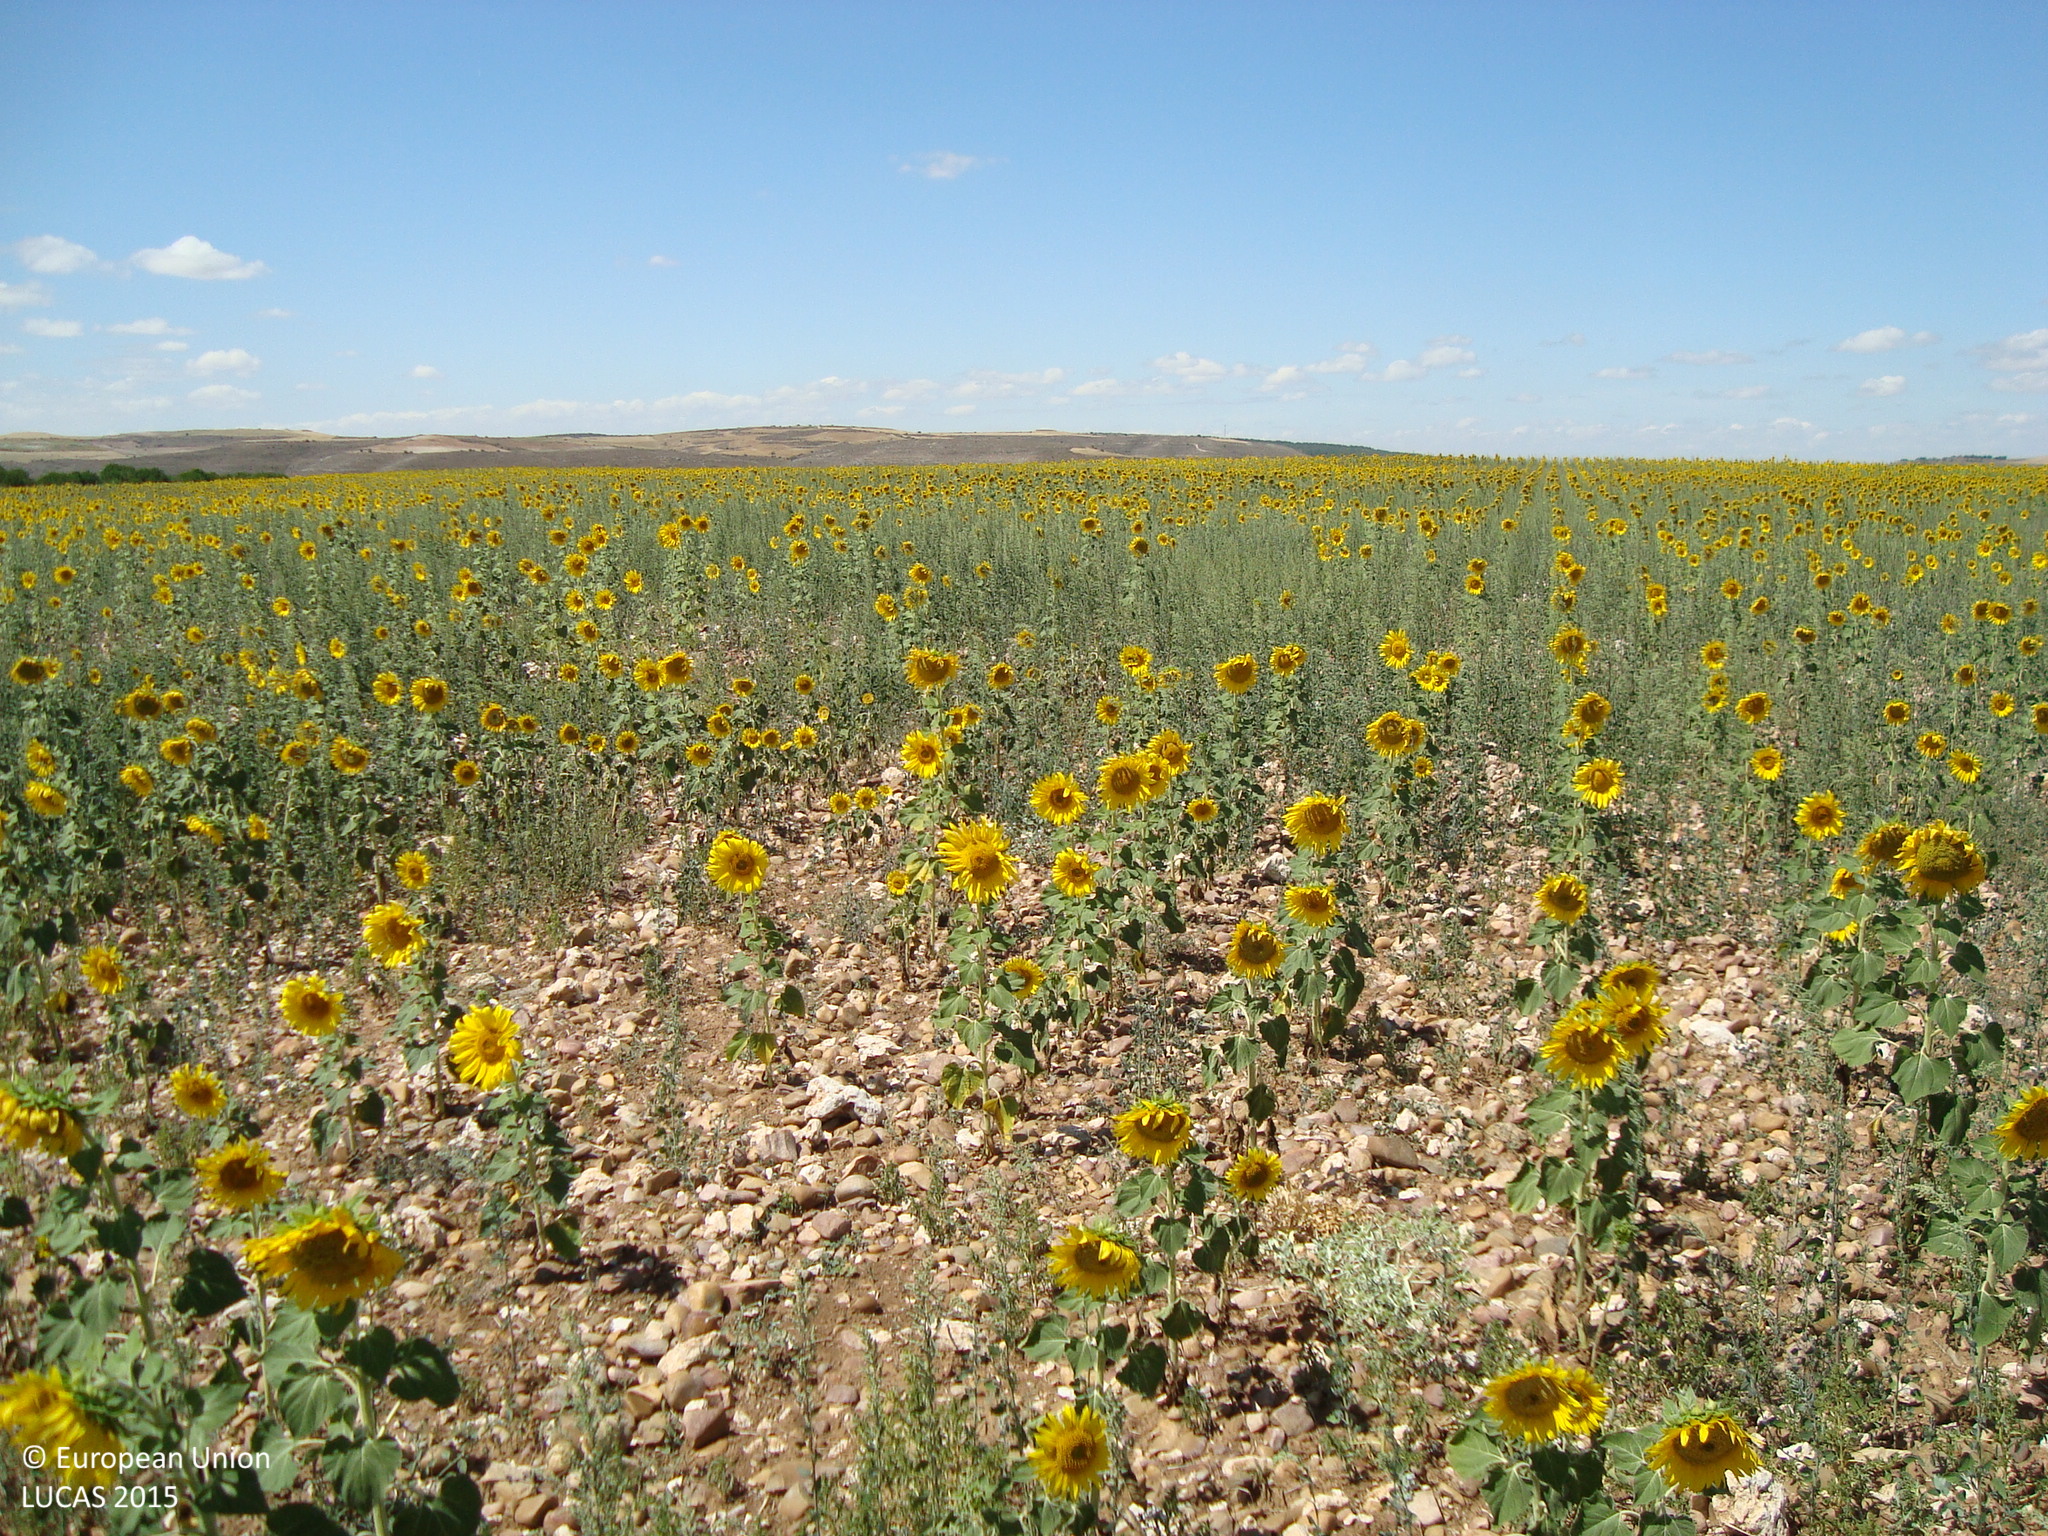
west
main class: Cropland
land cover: Sunflower
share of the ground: 10 - 25 %
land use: Agriculture (excluding fallow land and kitchen gardens)
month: August
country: ES
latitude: 42.0680
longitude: -3.9477
